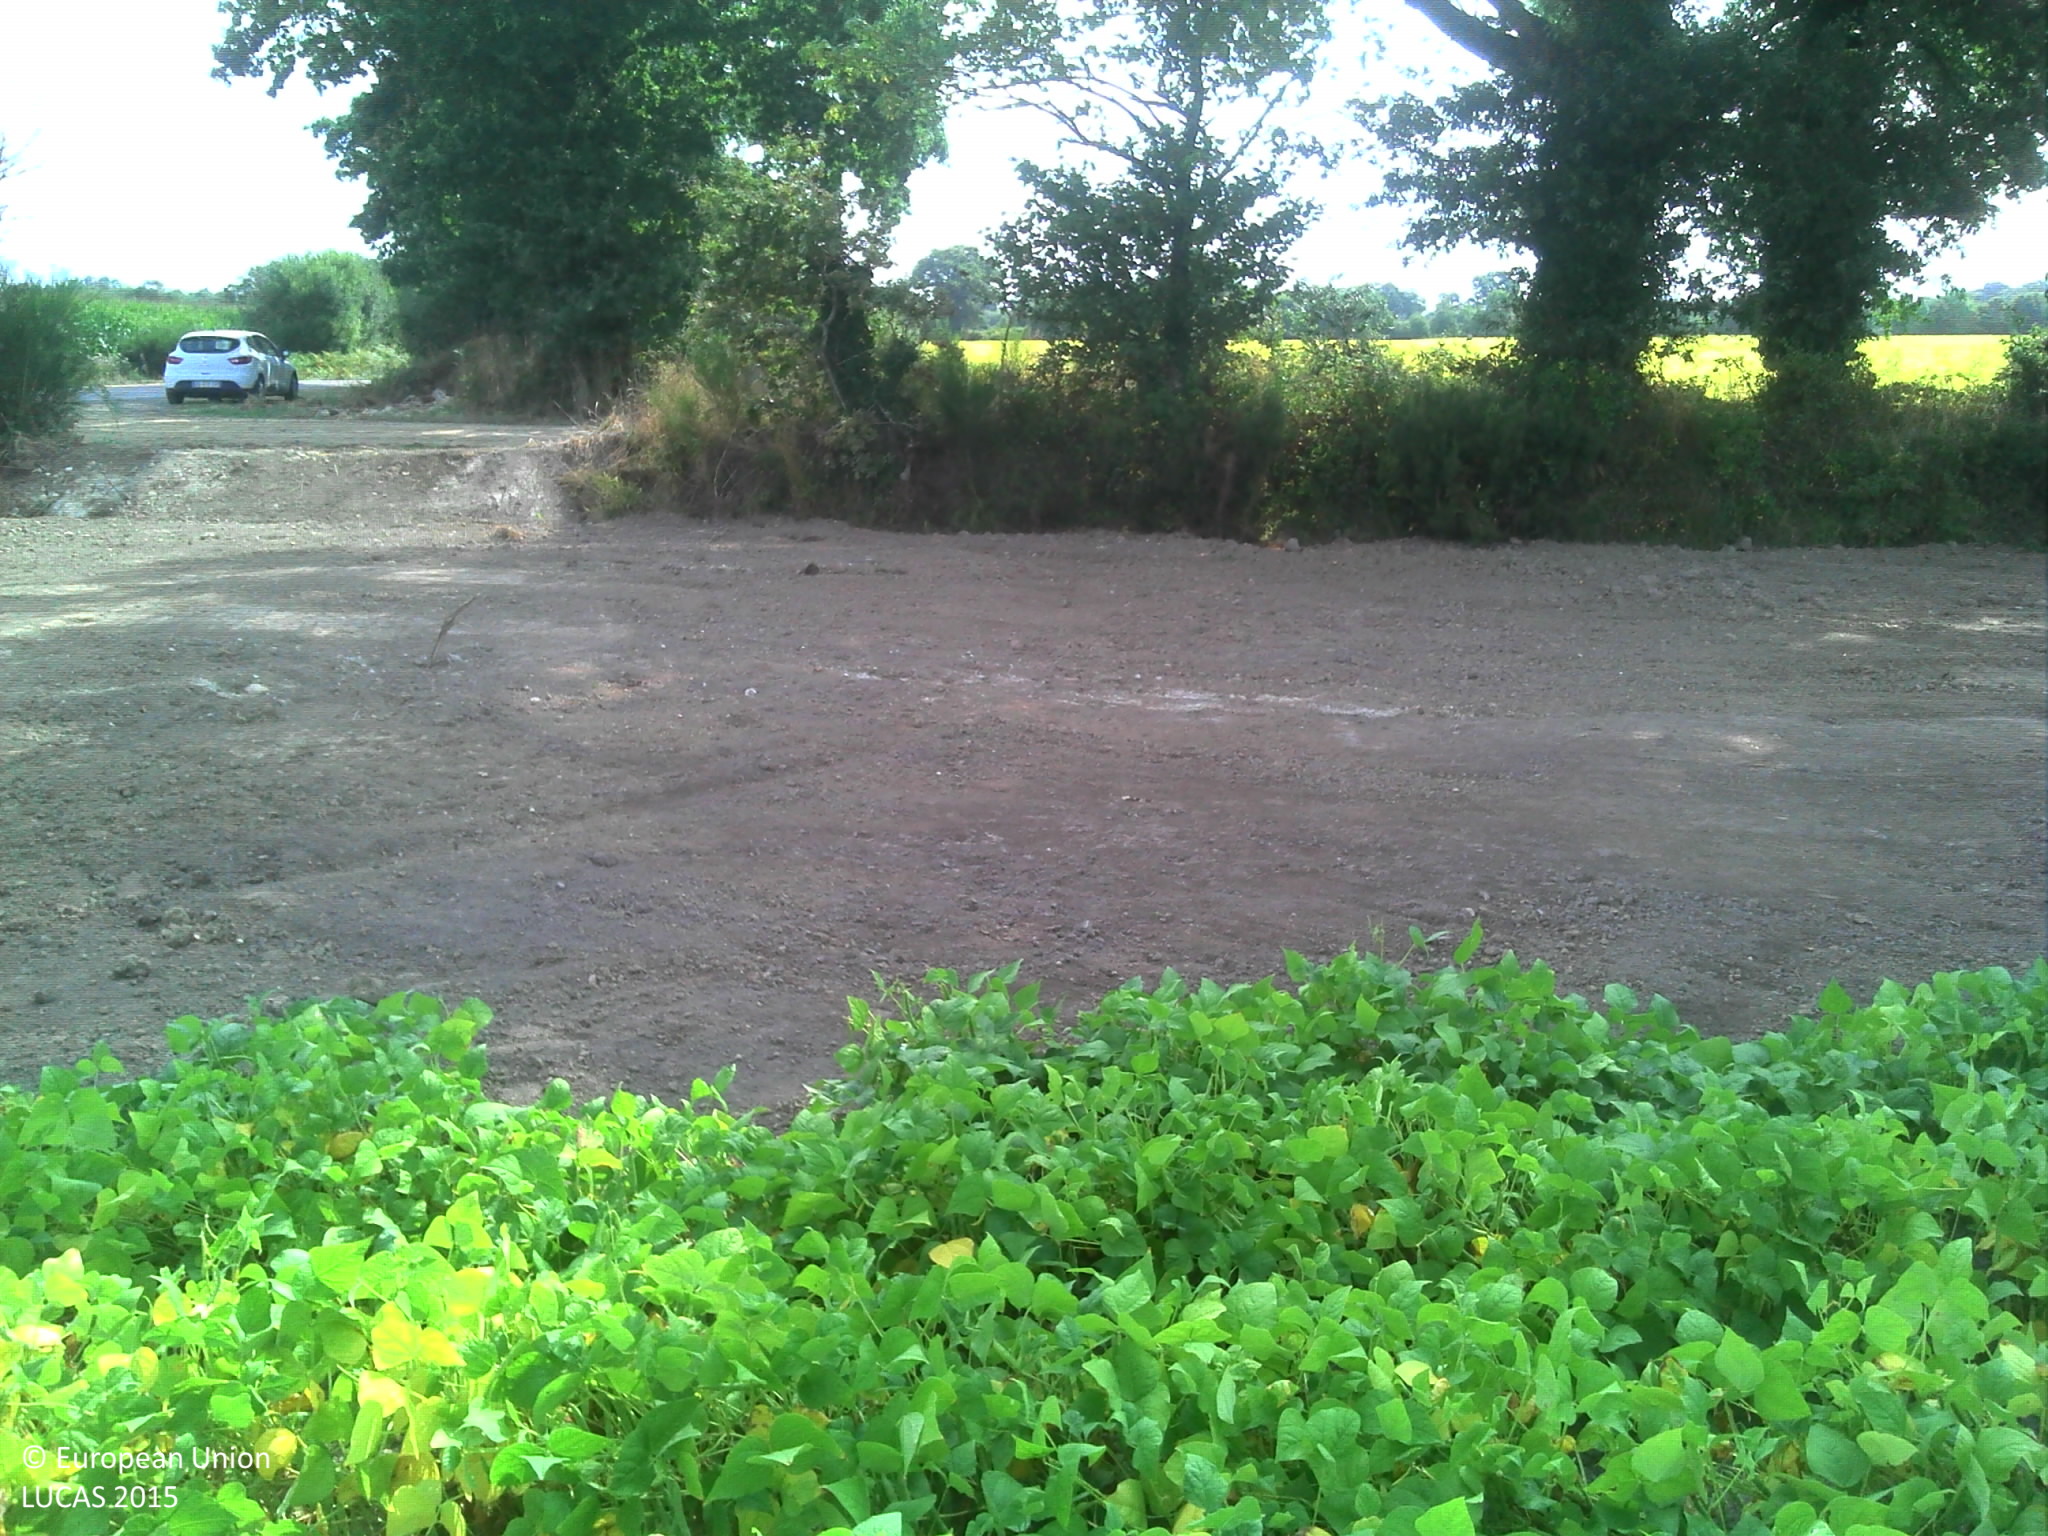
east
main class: Cropland
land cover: Dry pulses
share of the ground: > 75 %
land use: Agriculture (excluding fallow land and kitchen gardens)
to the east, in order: Dry pulses; Other bare soil; Lines of trees; Ditches and canals; Grass margins; Tracks; Grass margins; Ditches and canals; Lines of trees; Dry pulses; Abandoned hedges; Electric lines; Abandoned hedges; Electric lines; Abandoned hedges
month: August
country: FR
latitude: 46.7047
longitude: -1.7216
